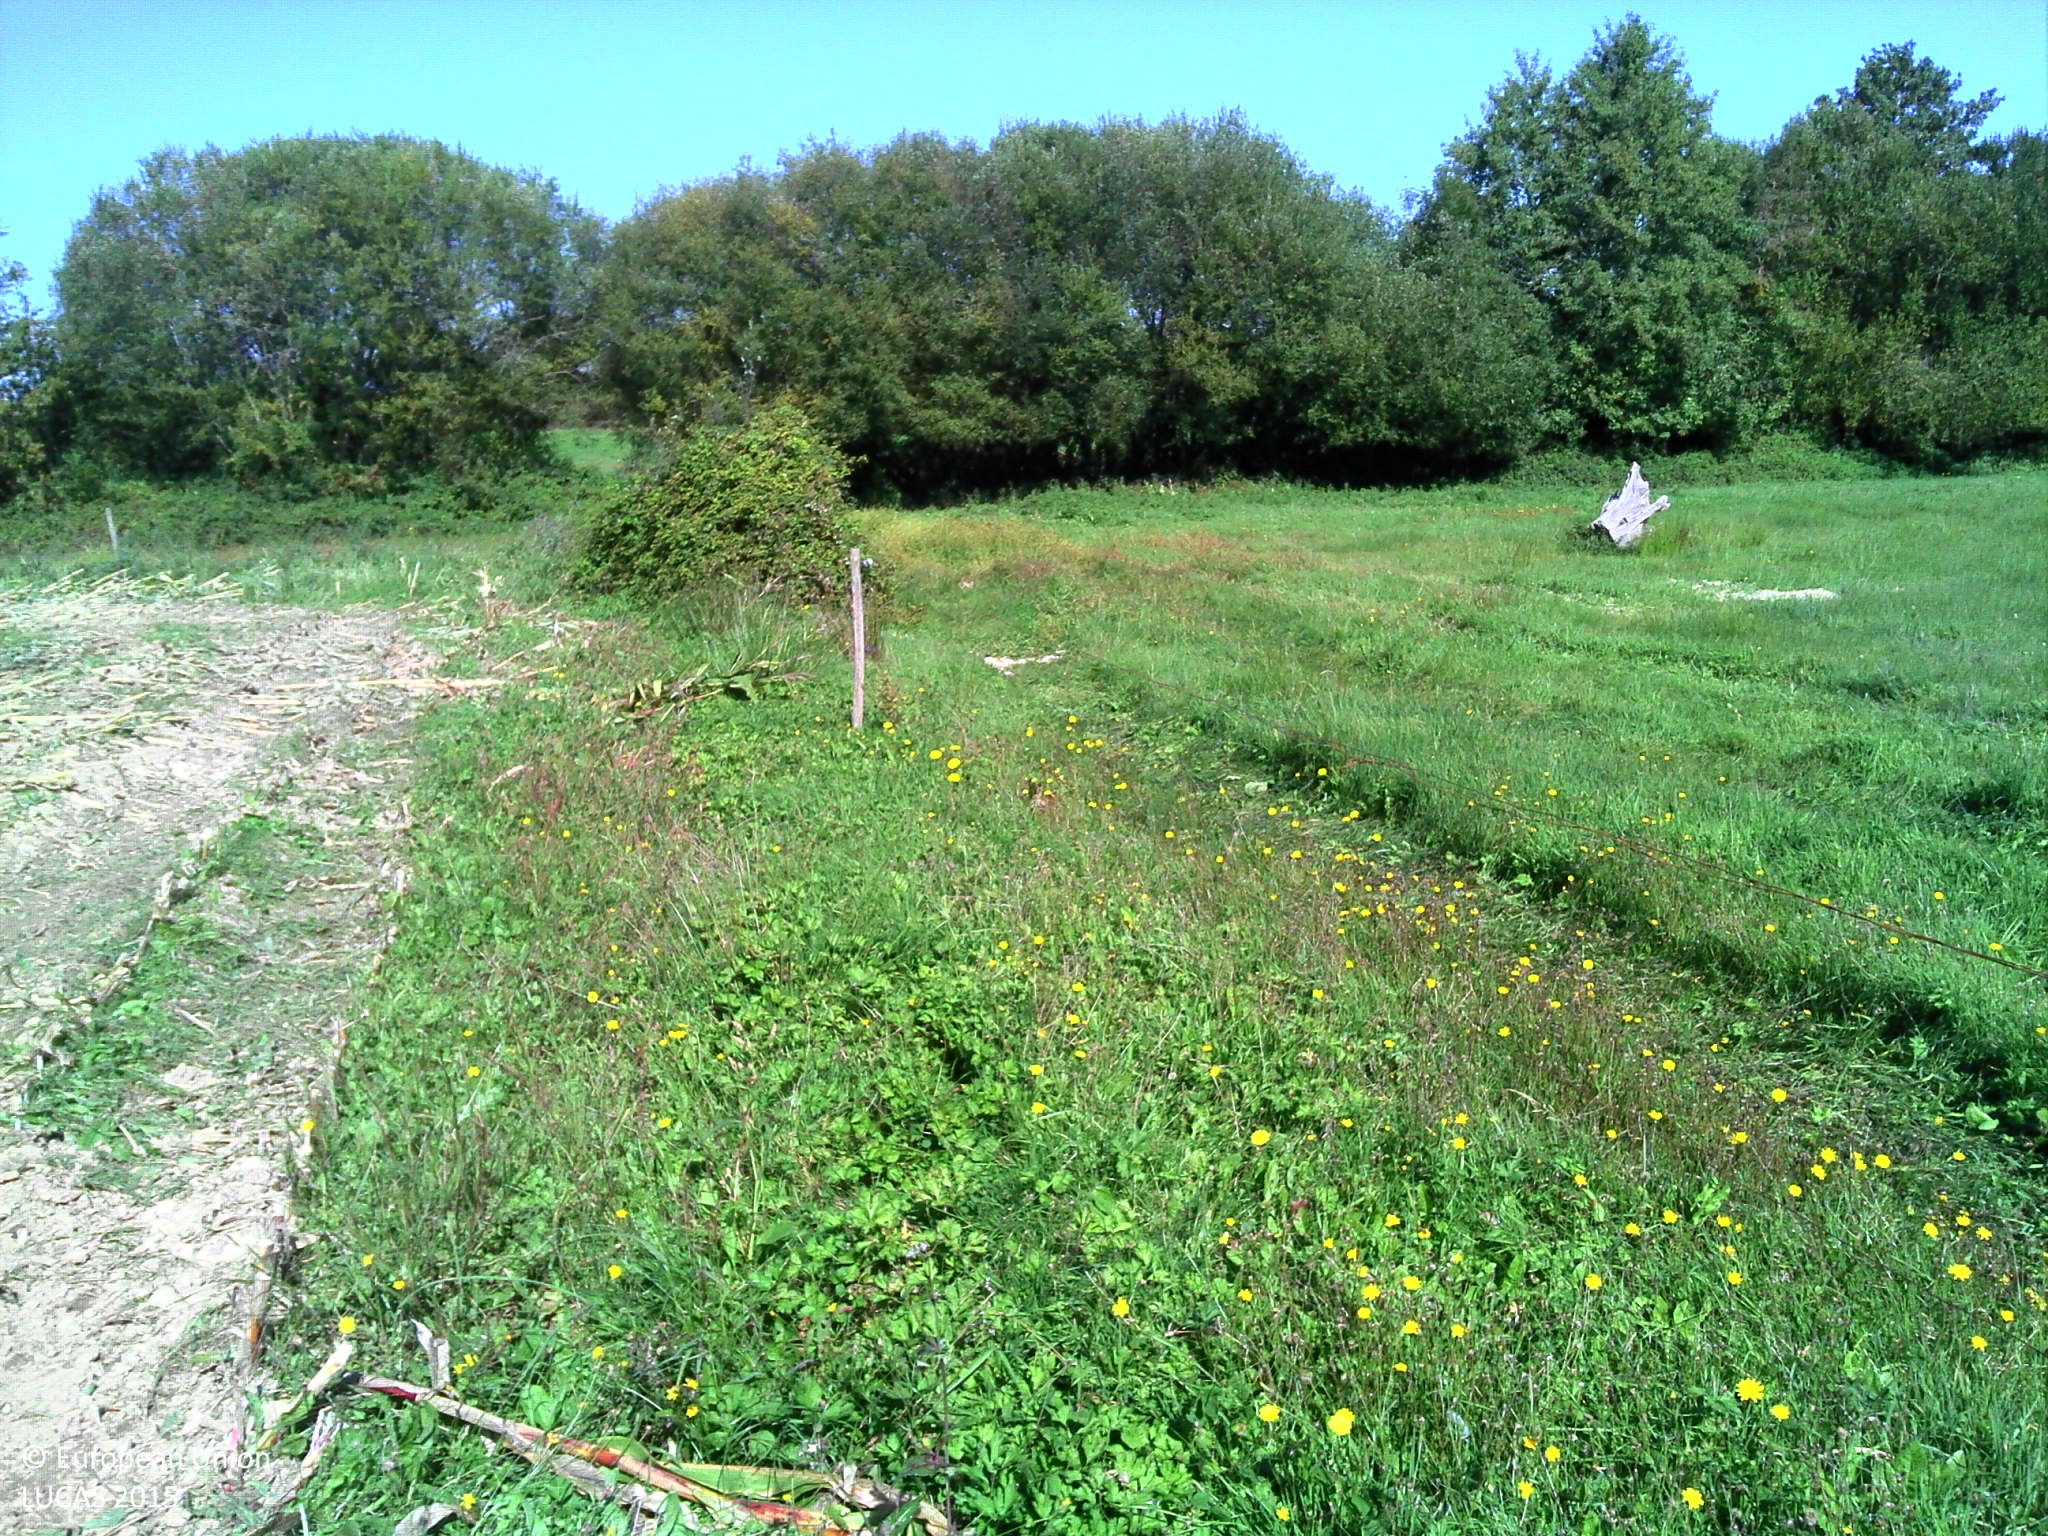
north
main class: Grassland
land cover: Grassland without tree/shrub cover
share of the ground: > 75 %
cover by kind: herbaceous plants 100 %
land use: Agriculture (excluding fallow land and kitchen gardens)
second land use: Amenities, museums, leisure
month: September
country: FR
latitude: 46.5689
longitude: -1.2950
